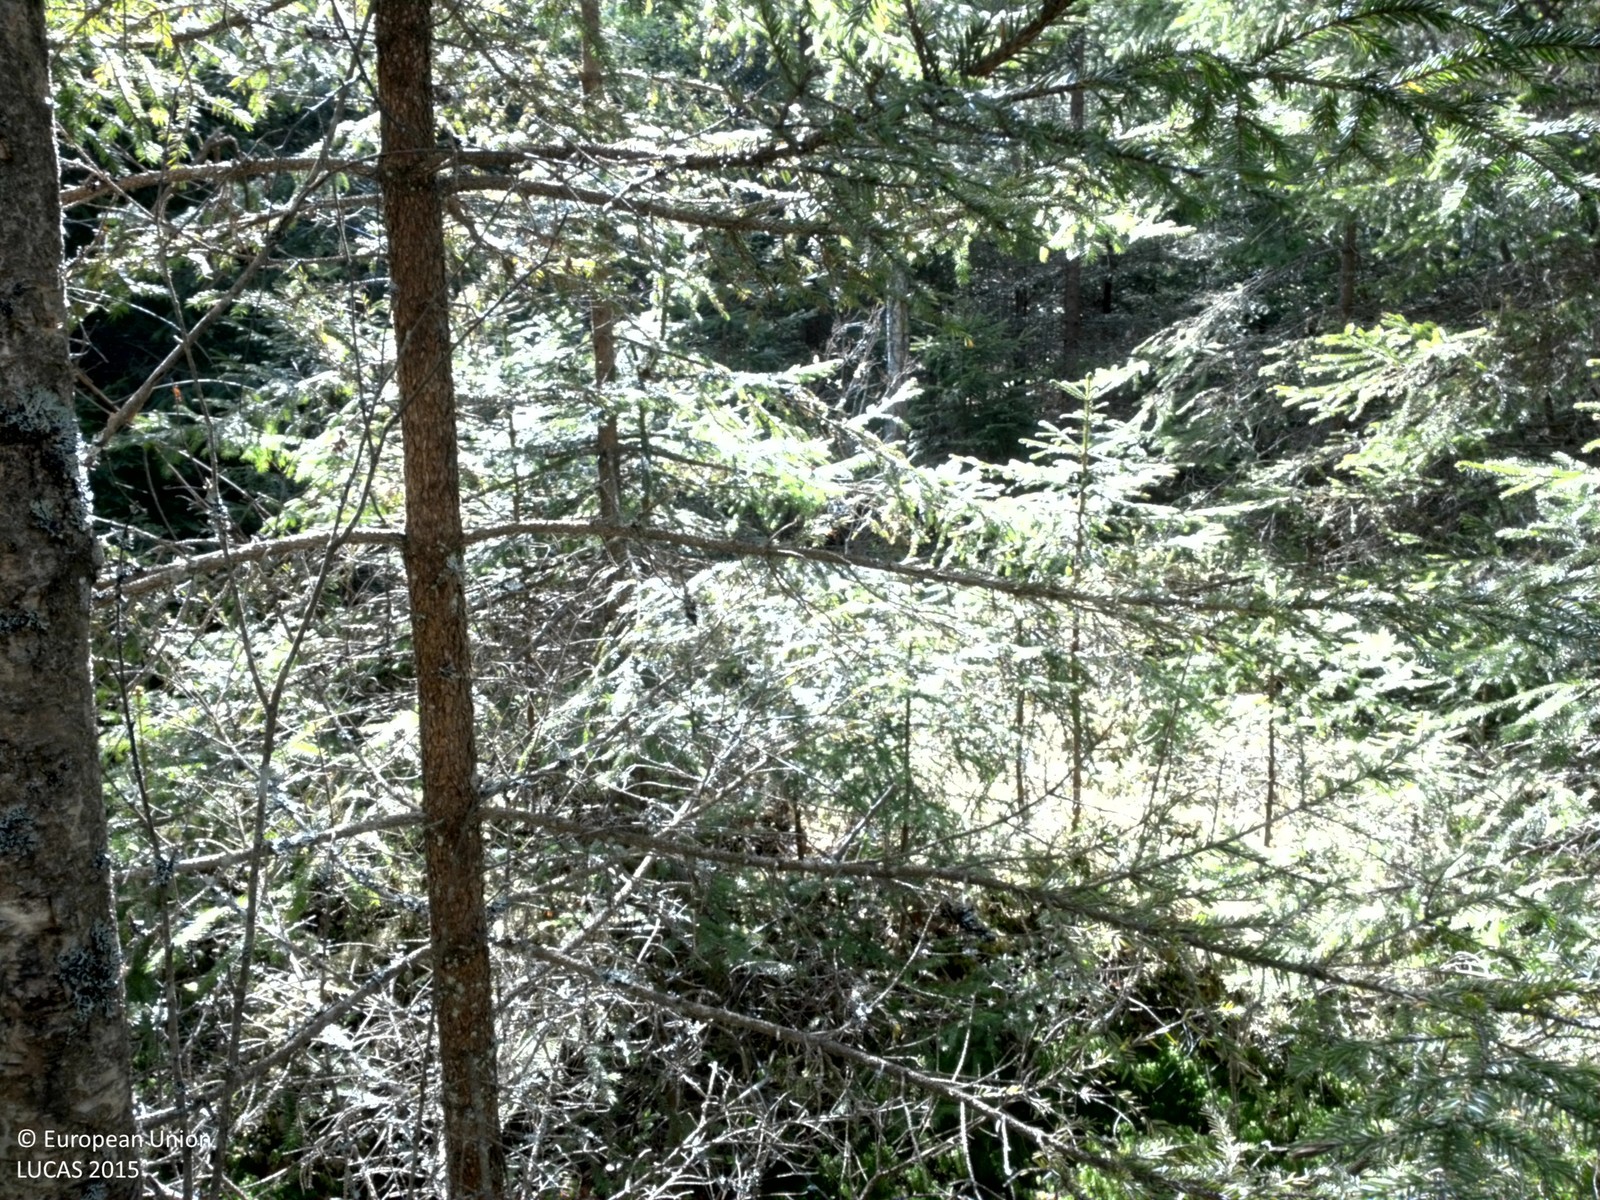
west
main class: Woodland
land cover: Spruce dominated mixed woodland
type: boreal forest
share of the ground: > 75 %
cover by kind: coniferous forest trees 75 %, broadleaved forest trees 25 %
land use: Forestry
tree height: > 5 m
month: May
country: SE
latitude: 56.5421
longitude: 15.4145
